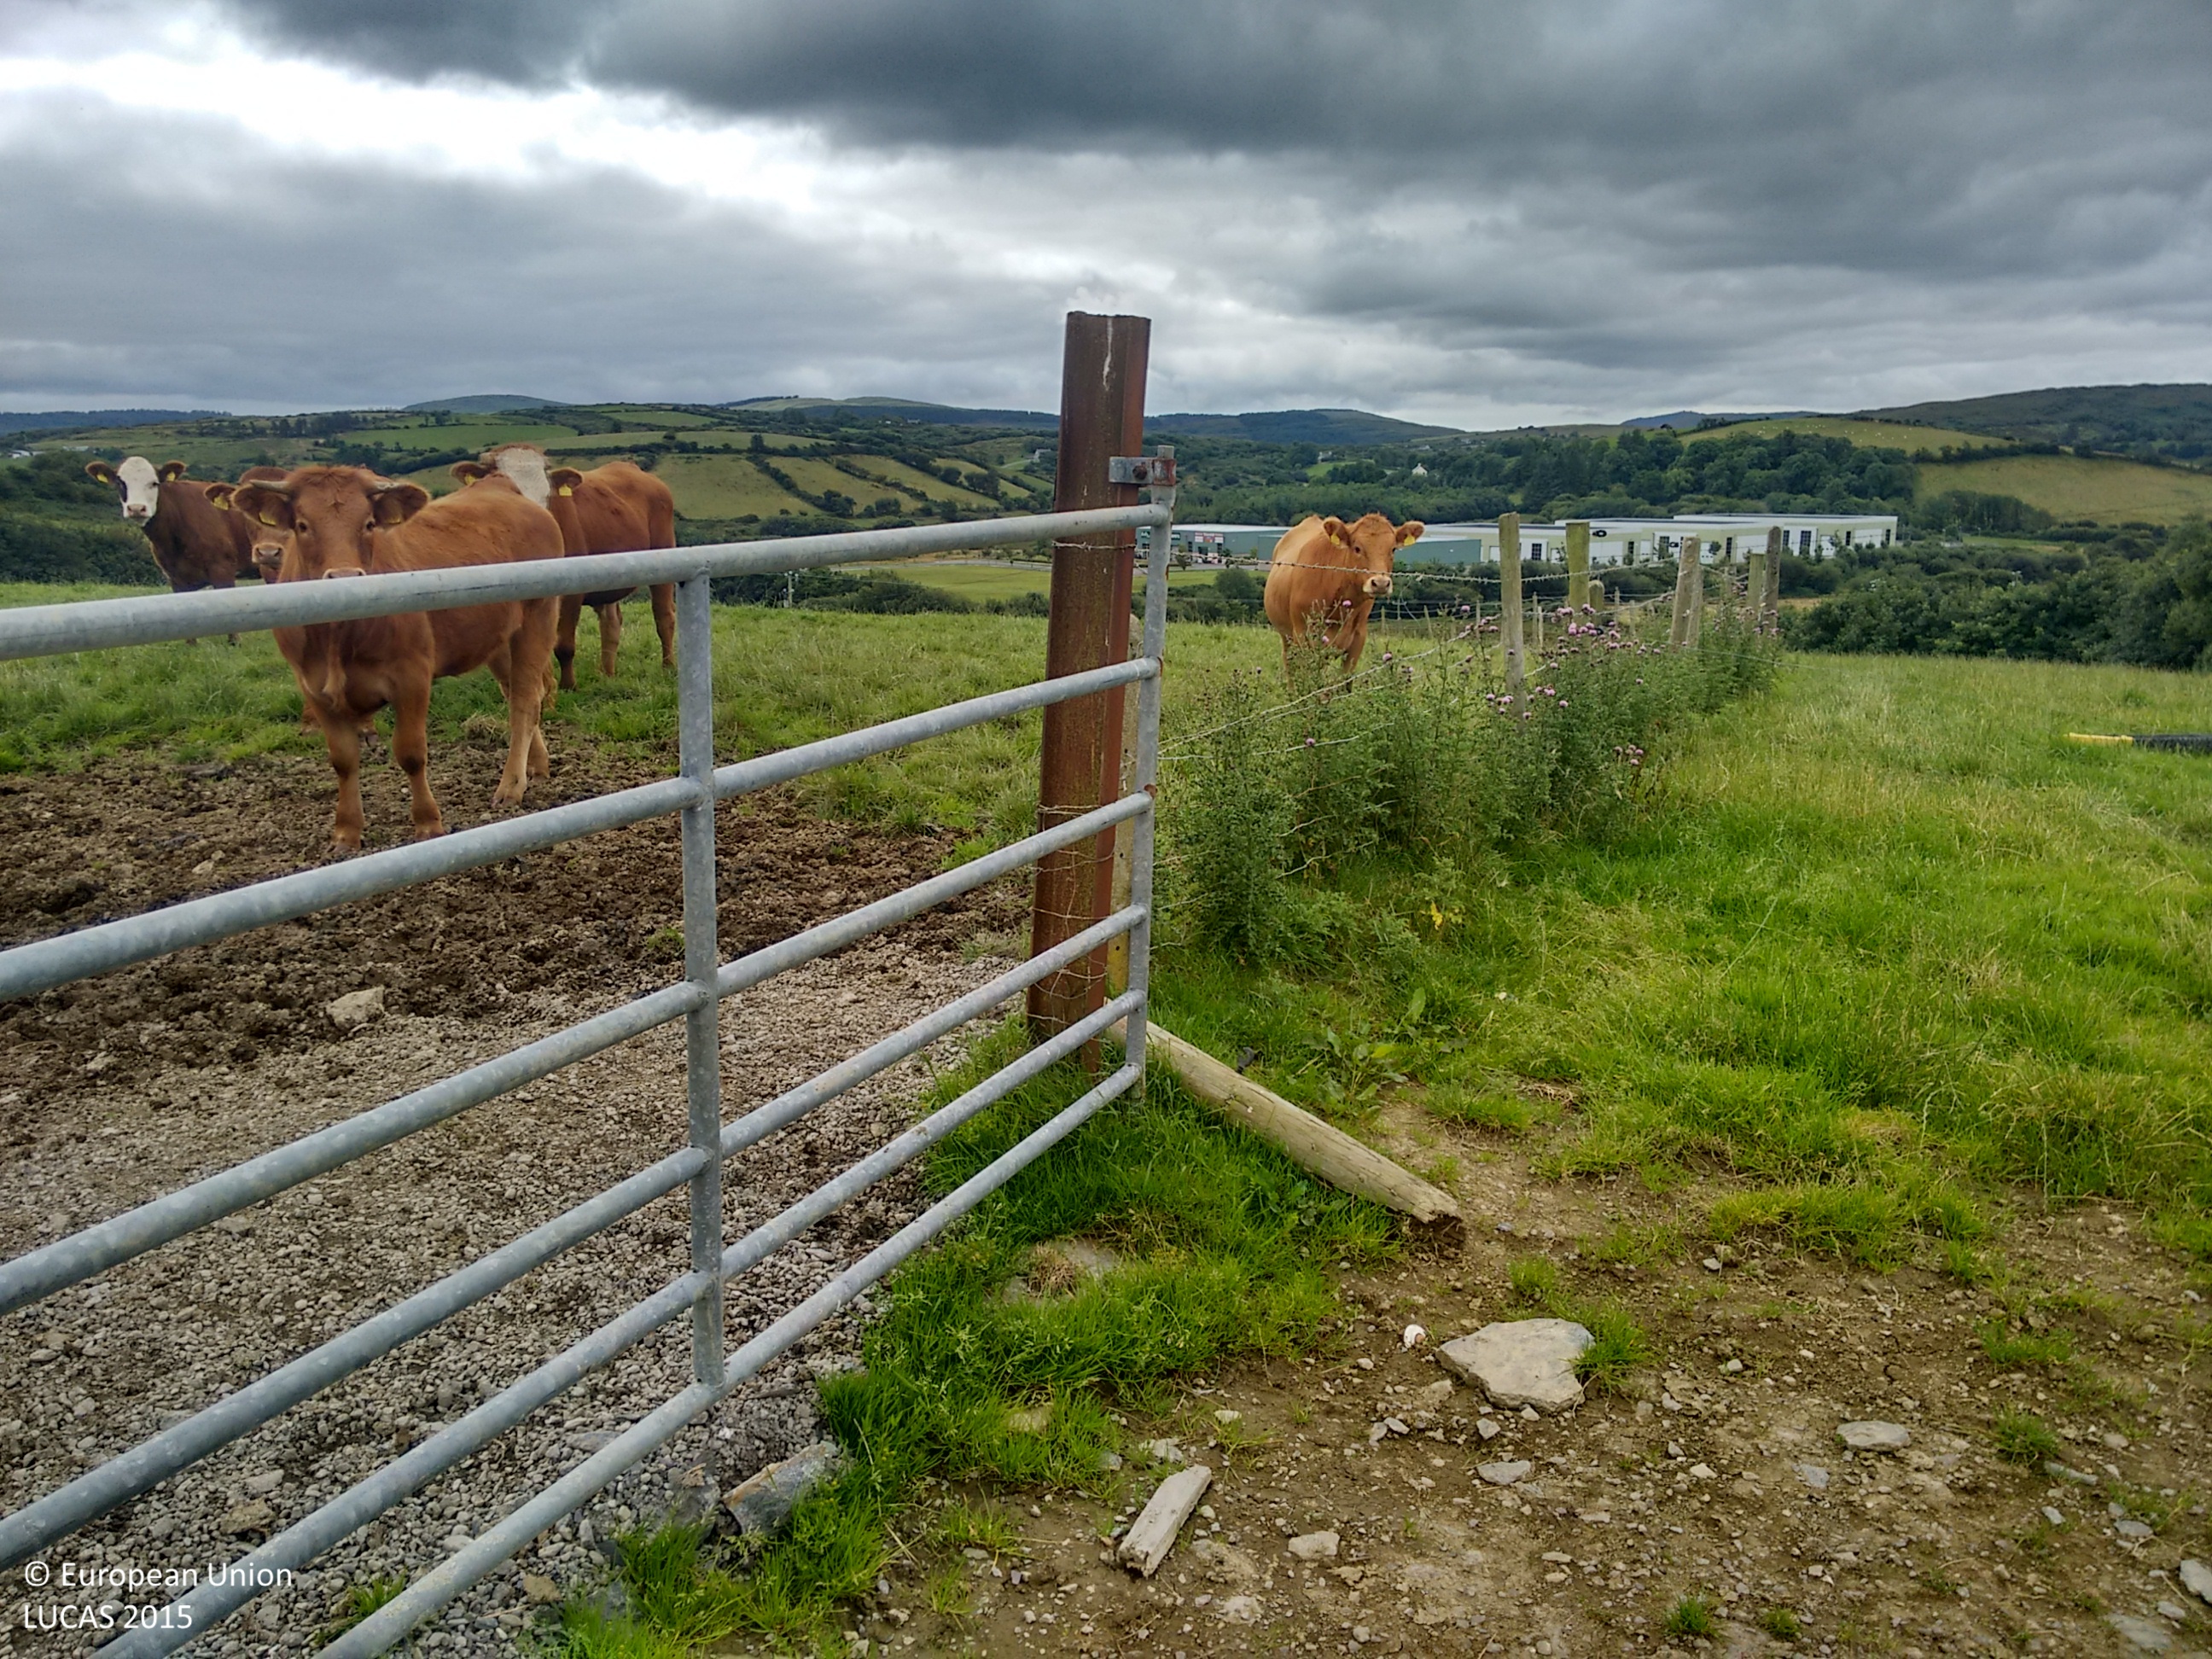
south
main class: Grassland
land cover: Grassland without tree/shrub cover
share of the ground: > 75 %
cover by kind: herbaceous plants 100 %
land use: Agriculture (excluding fallow land and kitchen gardens)
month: August
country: IE
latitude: 51.6669
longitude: -9.4761
